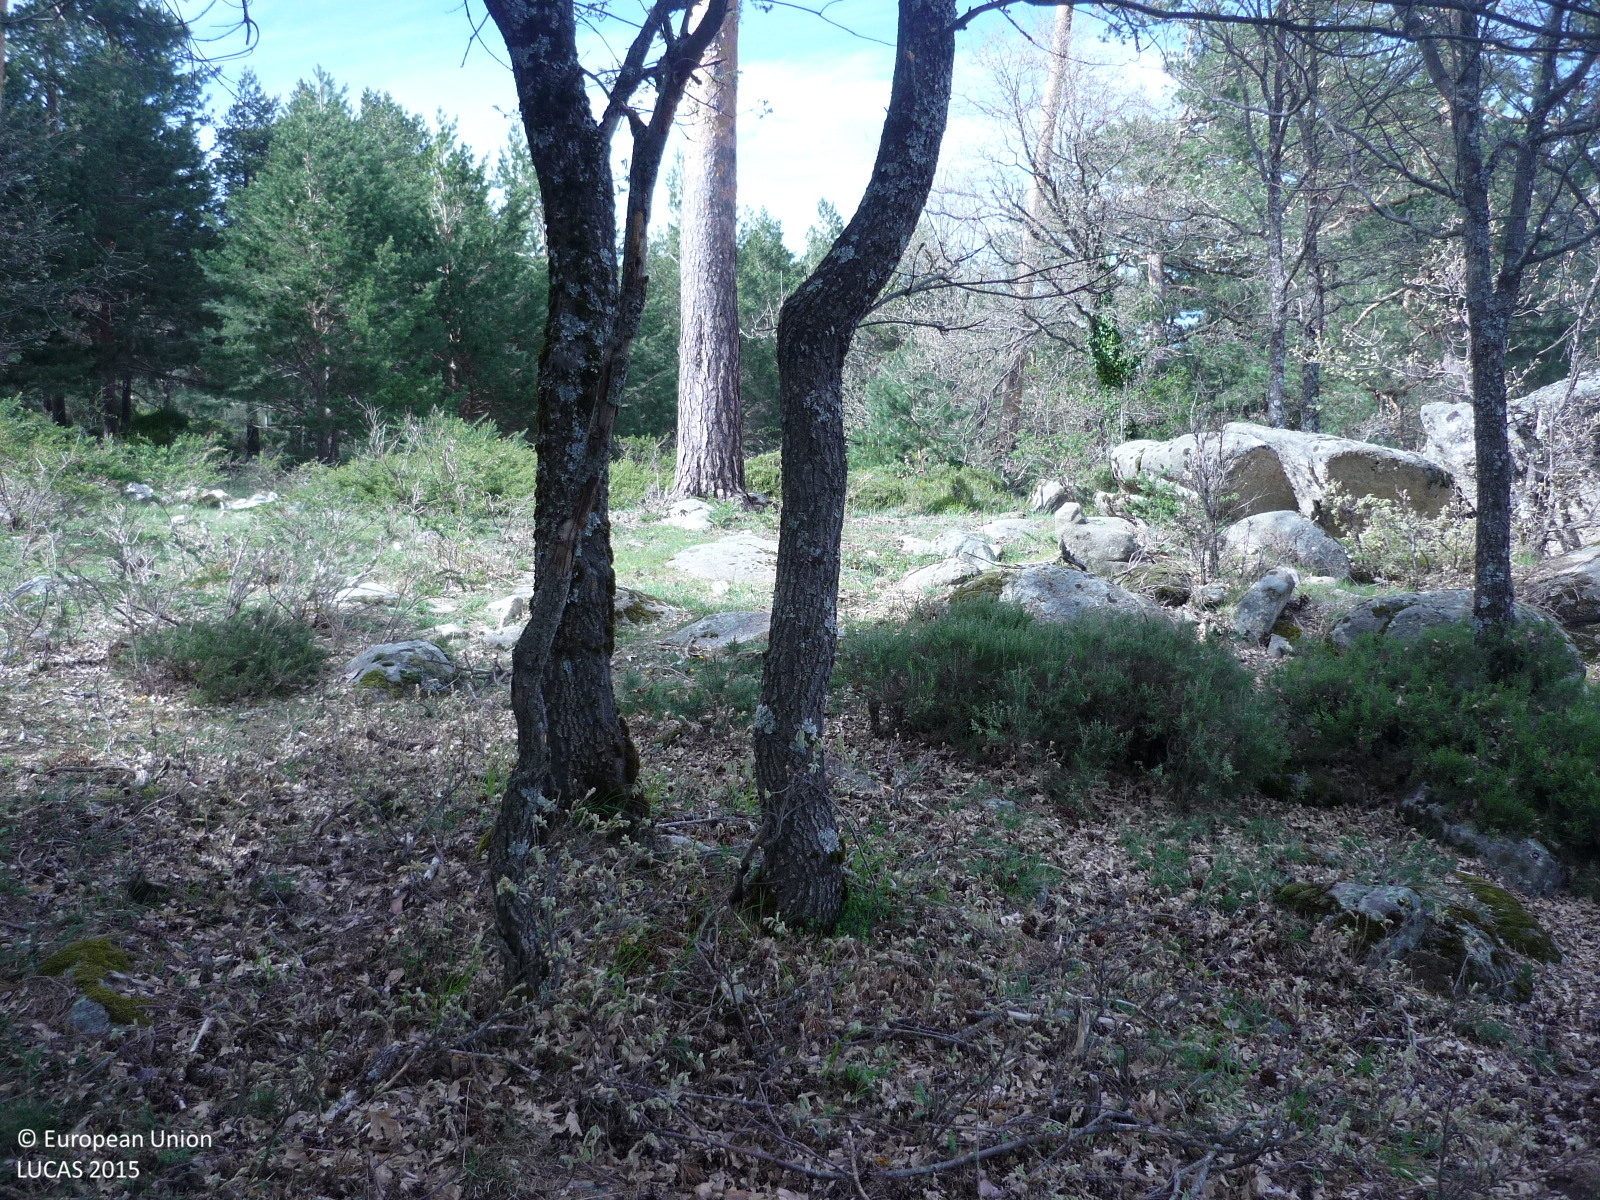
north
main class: Woodland
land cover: Pine dominated coniferous woodland
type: coniferous forest of the mediterranean region
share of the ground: > 75 %
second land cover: Grassland without tree/shrub cover
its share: 25 - 50 %
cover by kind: coniferous forest trees 85 %, shrubs 10 %, herbaceous plants 5 %
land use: Forestry
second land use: Agriculture (excluding fallow land and kitchen gardens)
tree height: > 5 m
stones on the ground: < 10 %
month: May
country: ES
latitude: 40.8821
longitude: -3.9195
